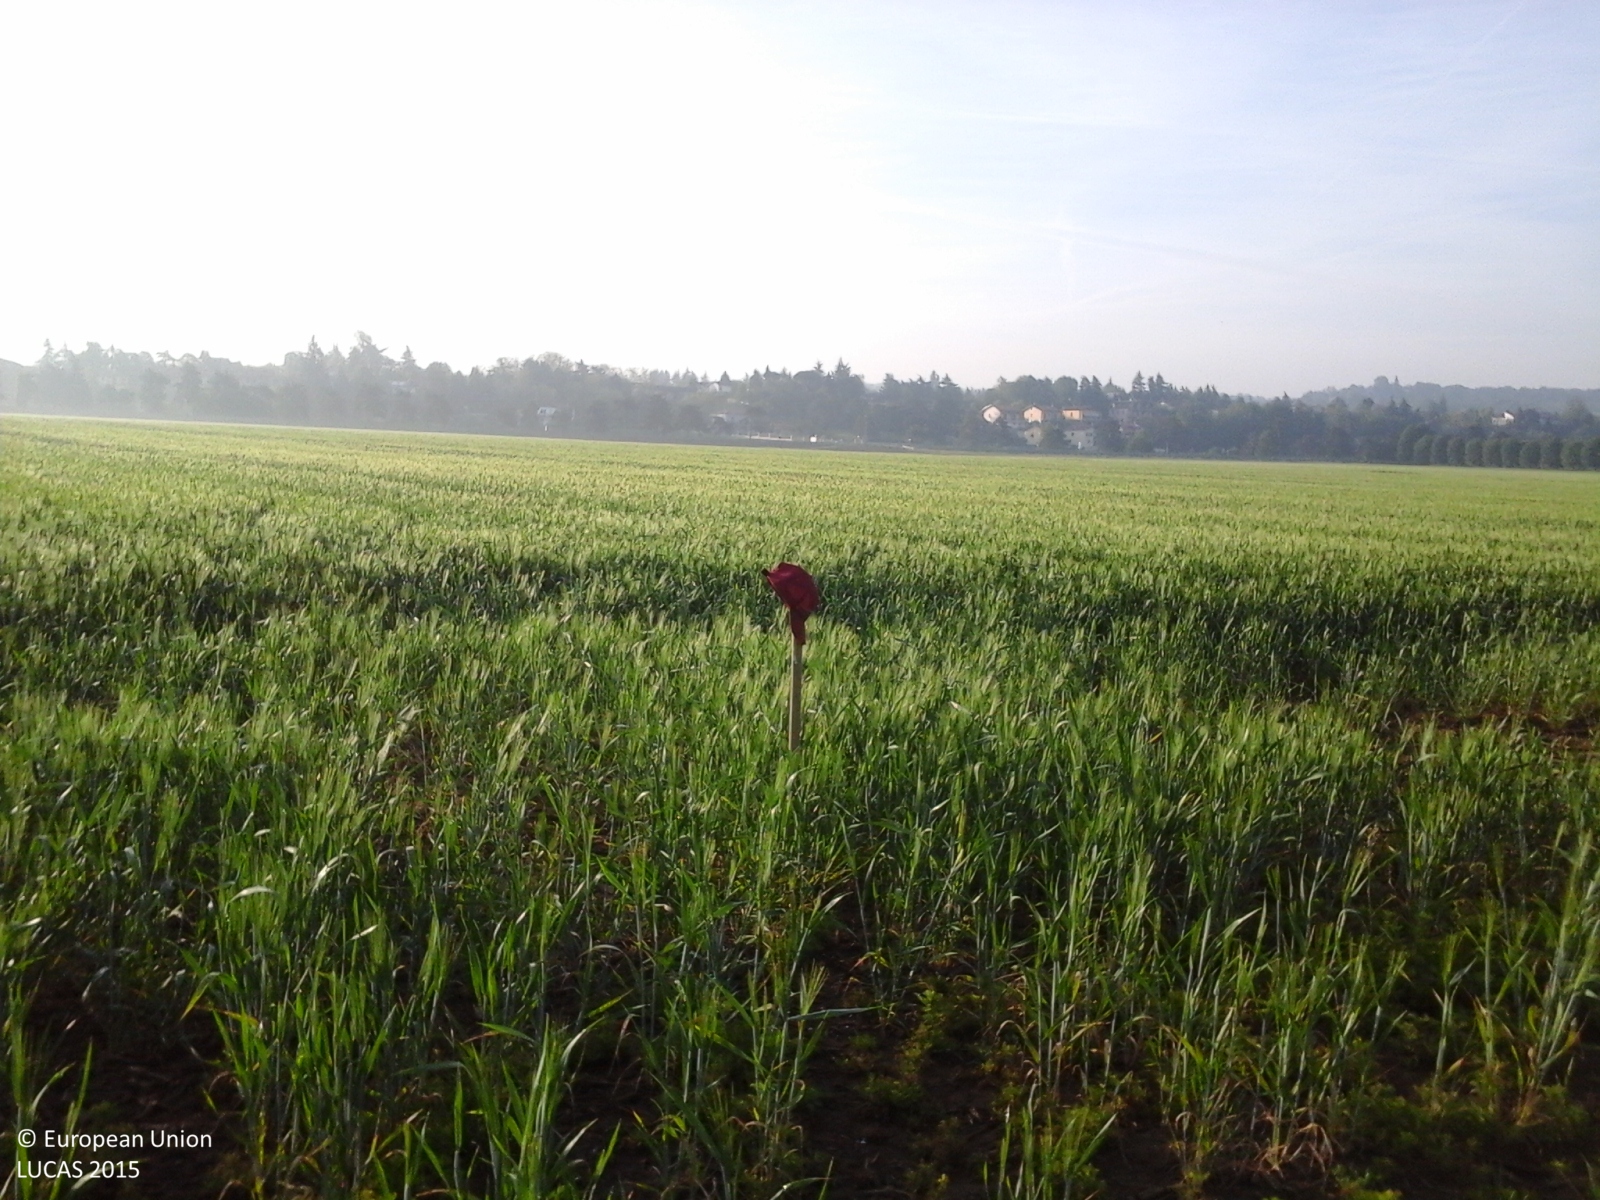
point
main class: Cropland
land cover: Common wheat
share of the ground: > 75 %
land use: Agriculture (excluding fallow land and kitchen gardens)
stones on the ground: < 10 %
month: May
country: IT
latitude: 44.9269
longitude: 9.6080
